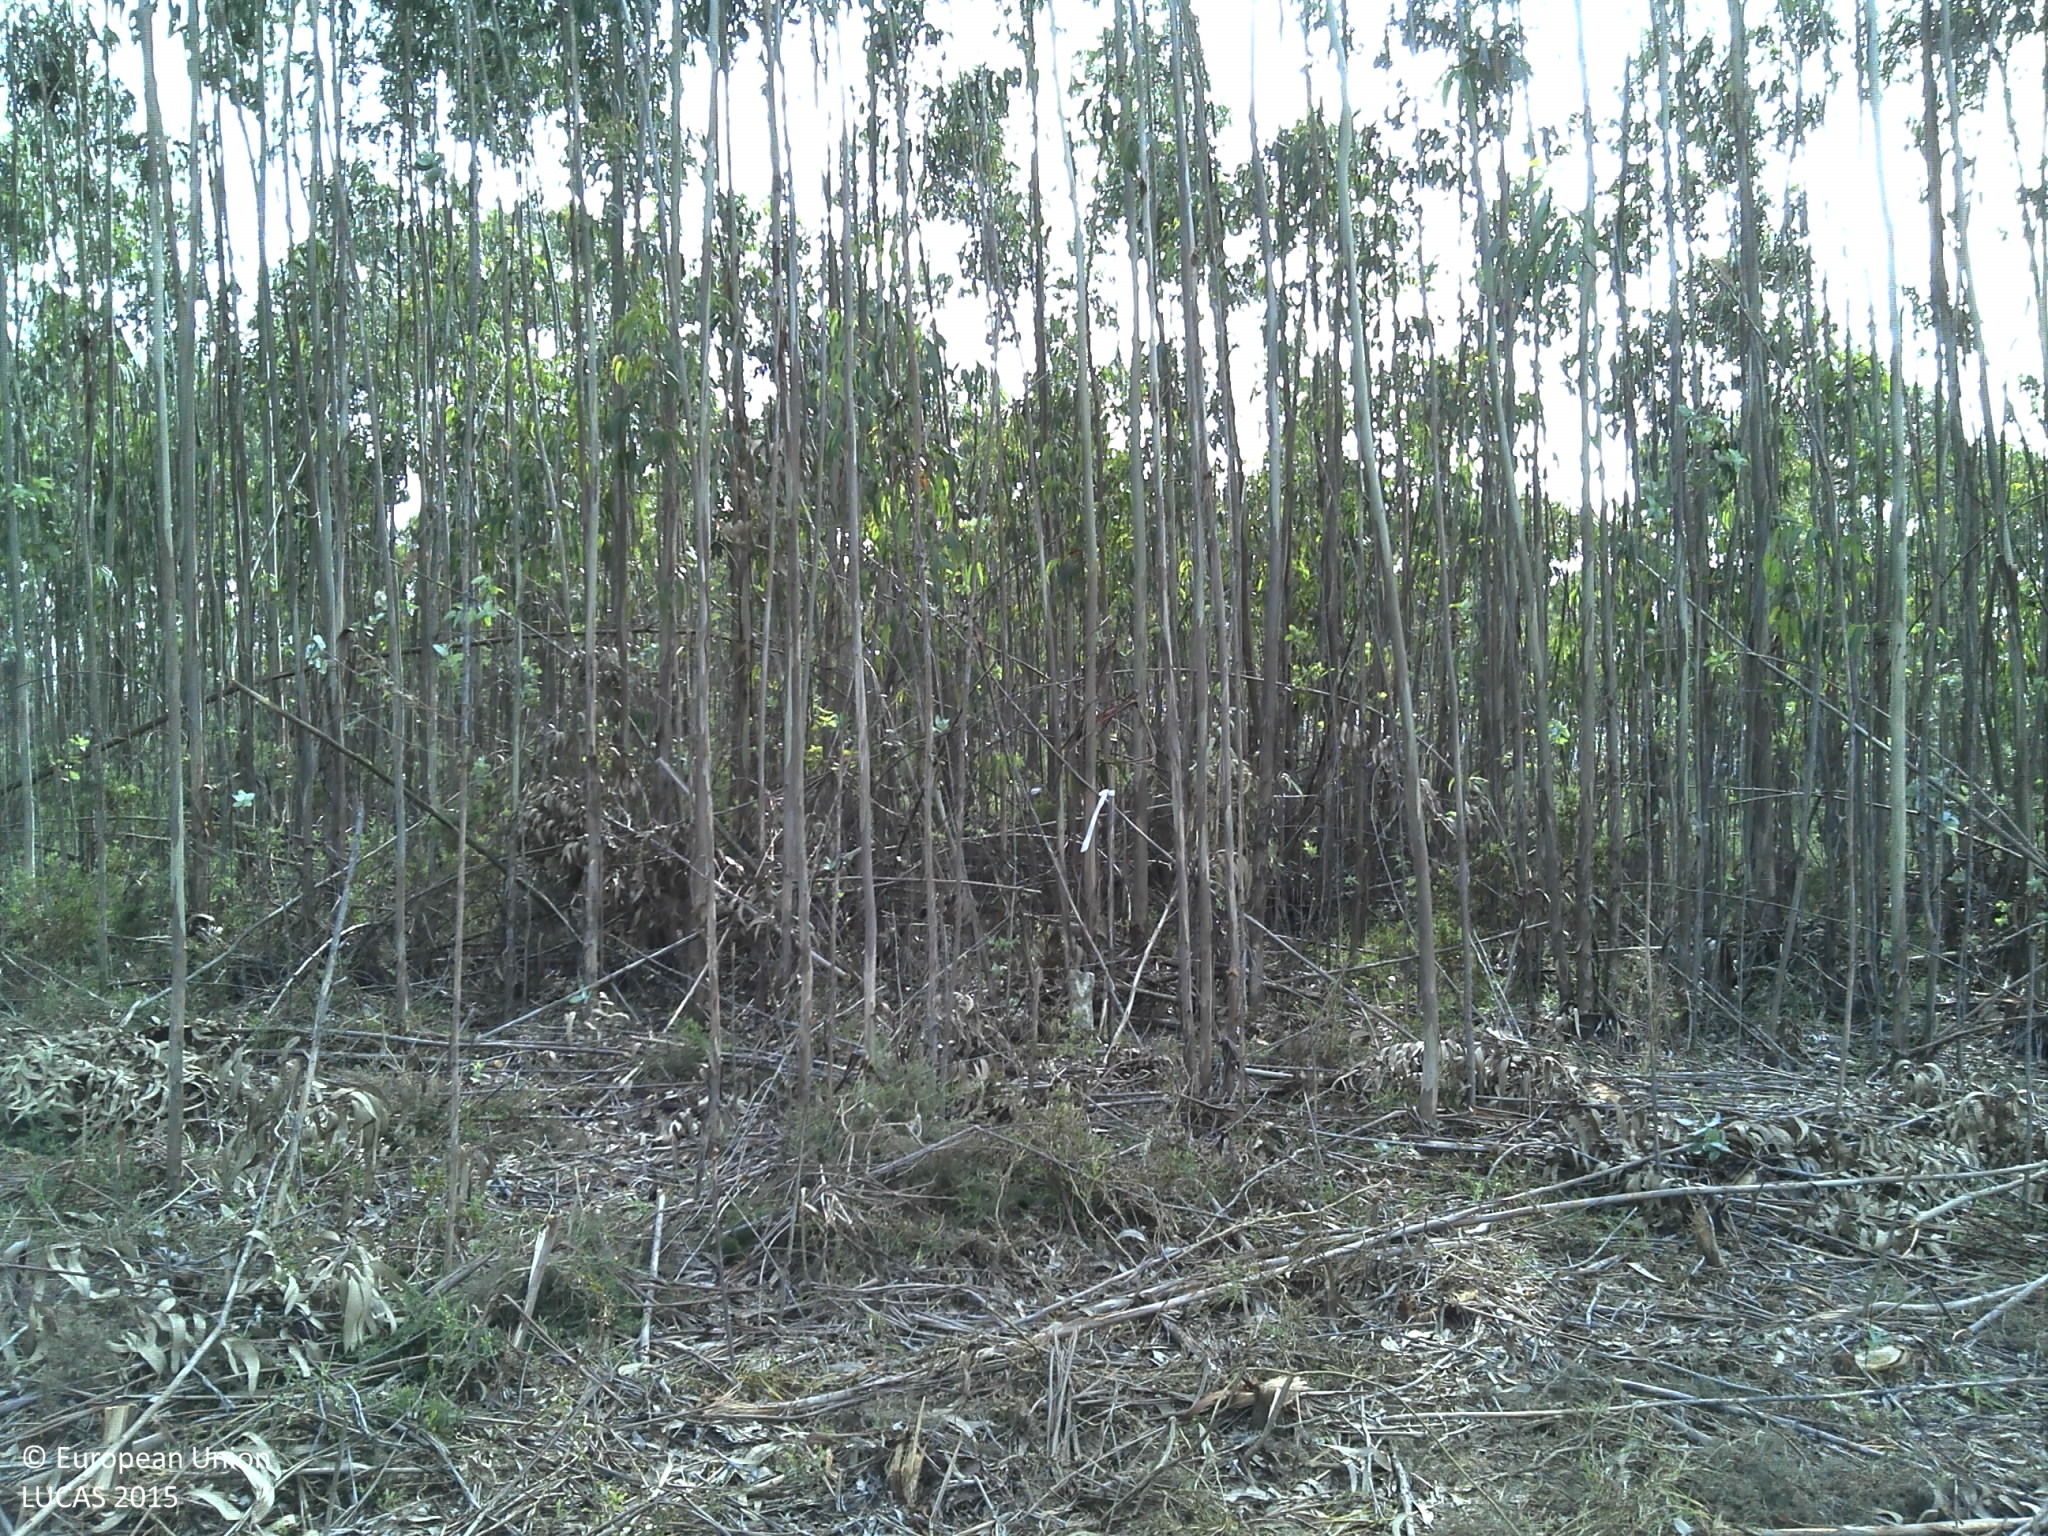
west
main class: Woodland
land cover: Broadleaved woodland
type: exotic forest
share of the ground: 25 - 50 %
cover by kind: broadleaved forest trees 50 %, shrubs 20 %, unconsolidated bare surface 20 %, herbaceous plants 10 %
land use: Forestry
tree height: > 5 m
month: May
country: PT
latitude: 41.0949
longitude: -8.4211
